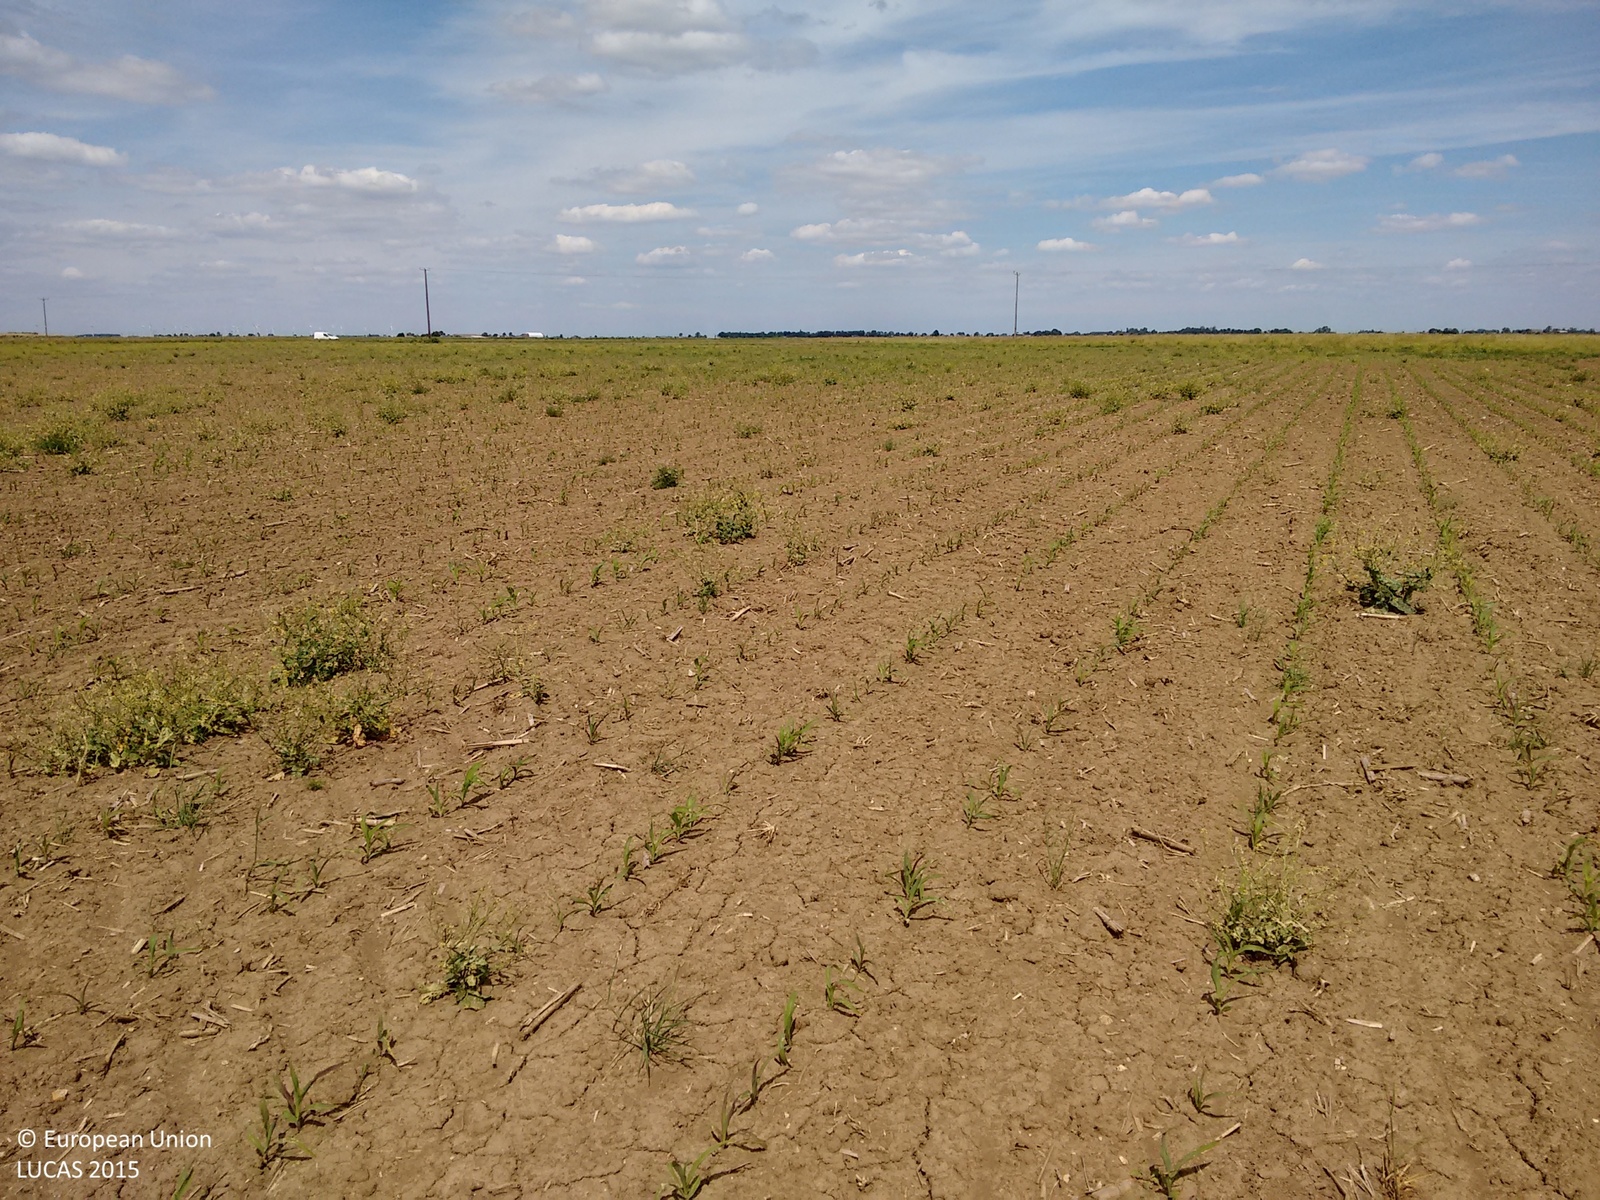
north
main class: Cropland
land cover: Maize
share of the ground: < 10 %
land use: Agriculture (excluding fallow land and kitchen gardens)
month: June
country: GB
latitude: 52.5120
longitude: 0.1706
